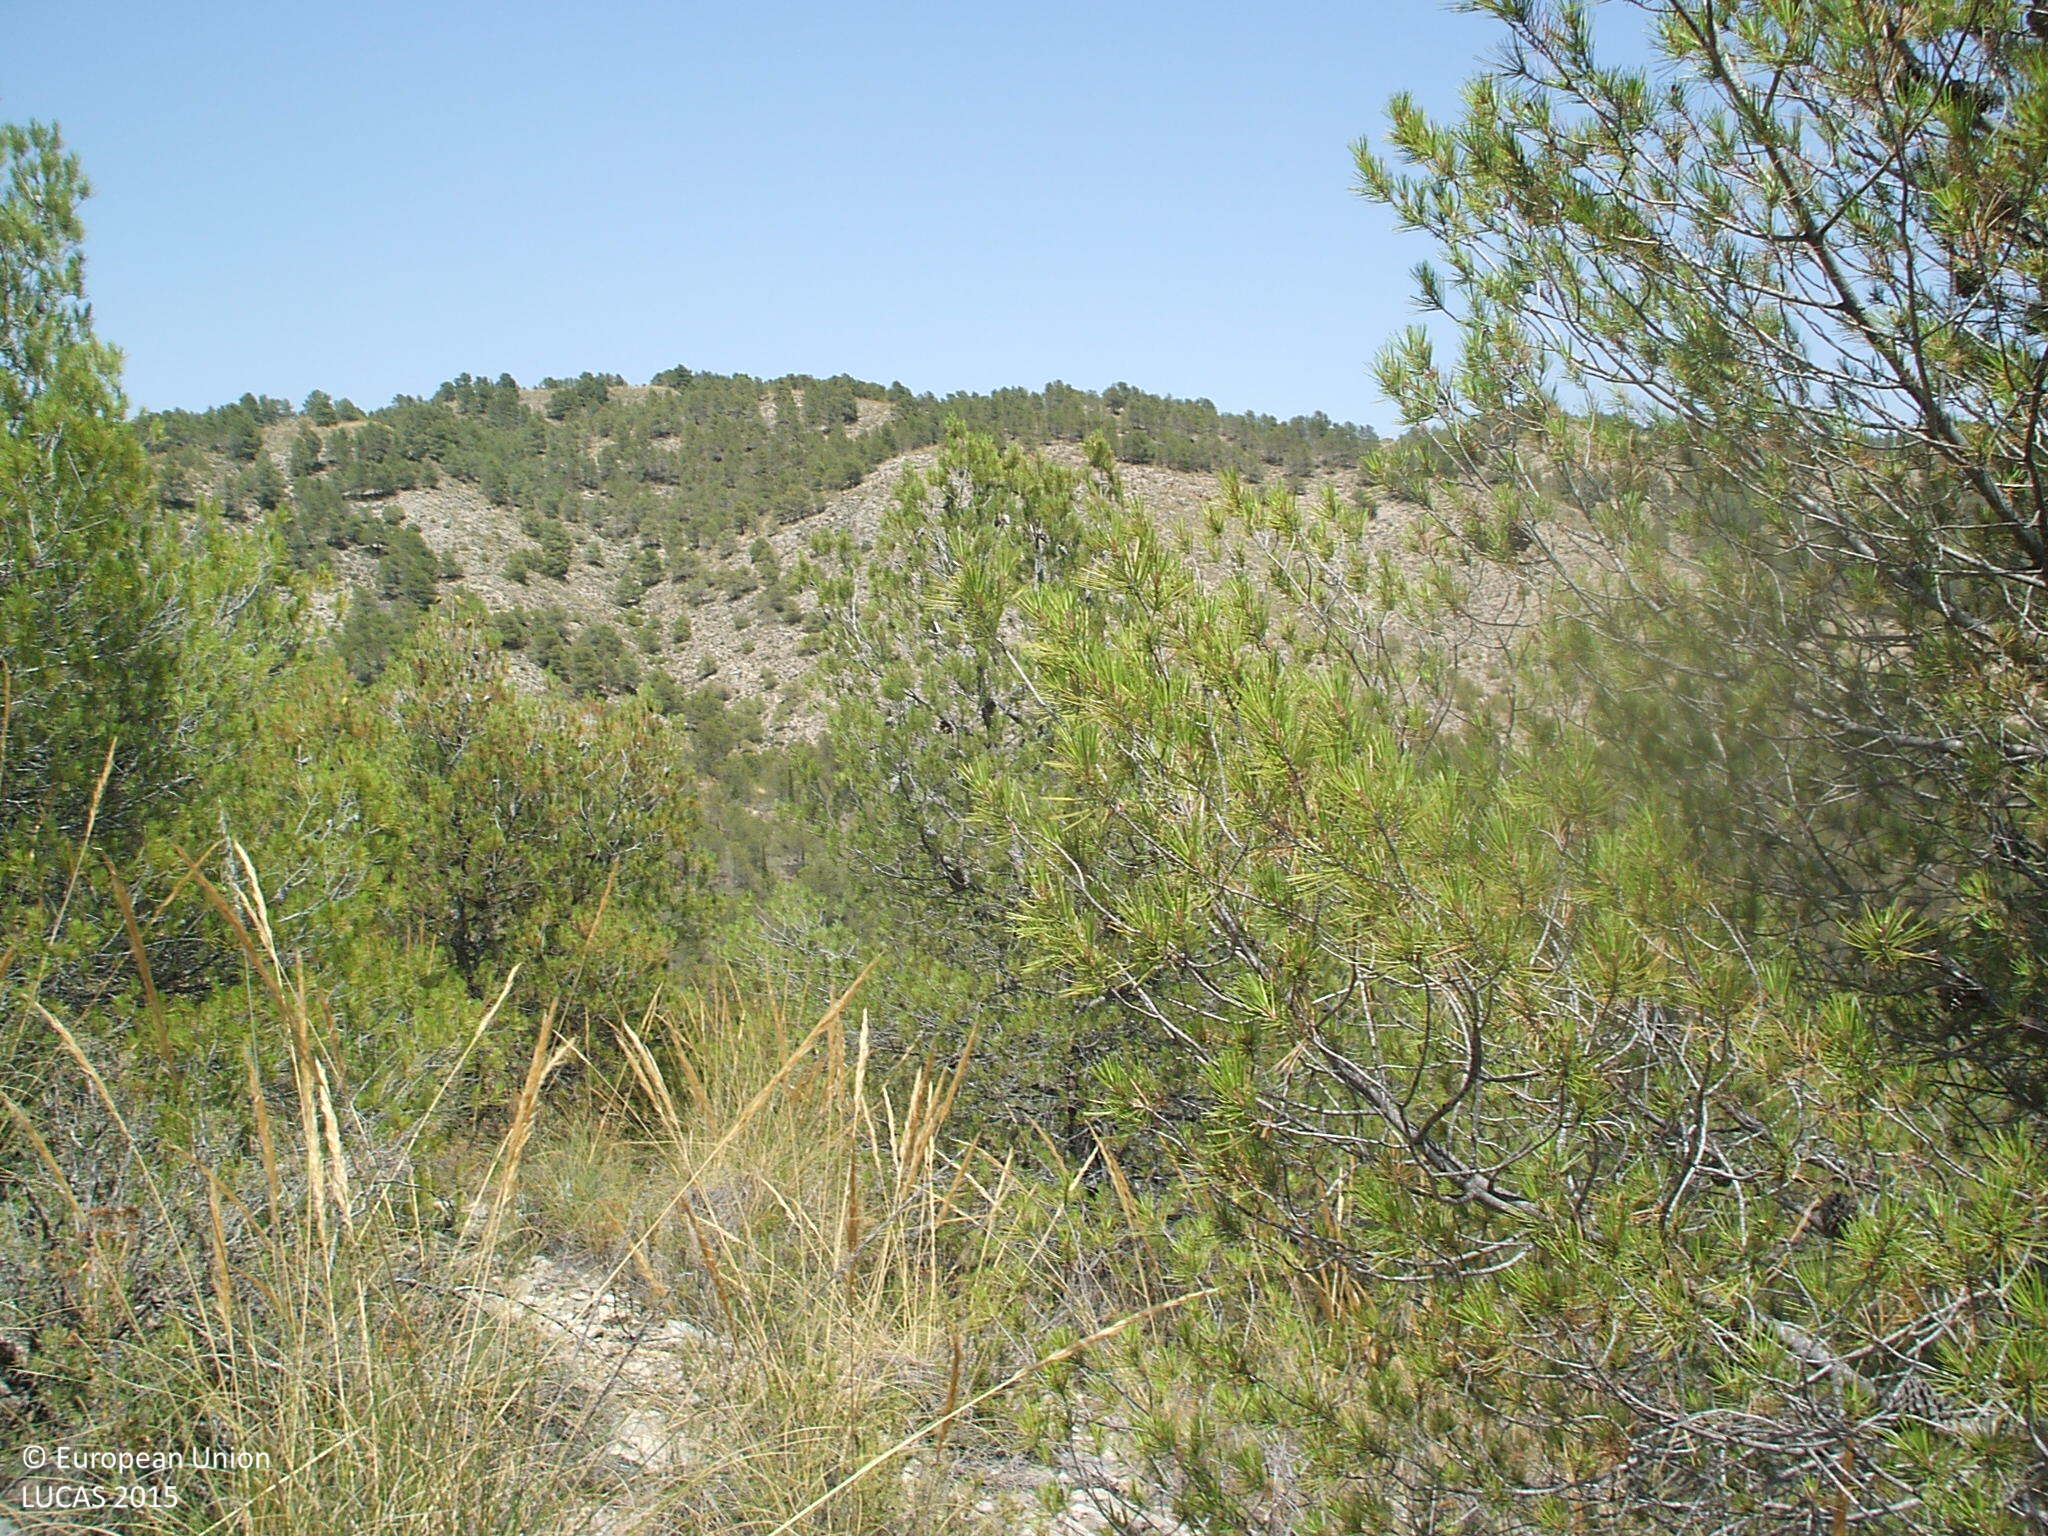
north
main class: Woodland
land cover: Pine dominated coniferous woodland
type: coniferous forest of the mediterranean region
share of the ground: 50 - 75 %
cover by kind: coniferous forest trees 70 %, consolidated bare surface 30 %
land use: Forestry
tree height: > 5 m
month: July
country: ES
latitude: 37.4091
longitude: -2.3995
